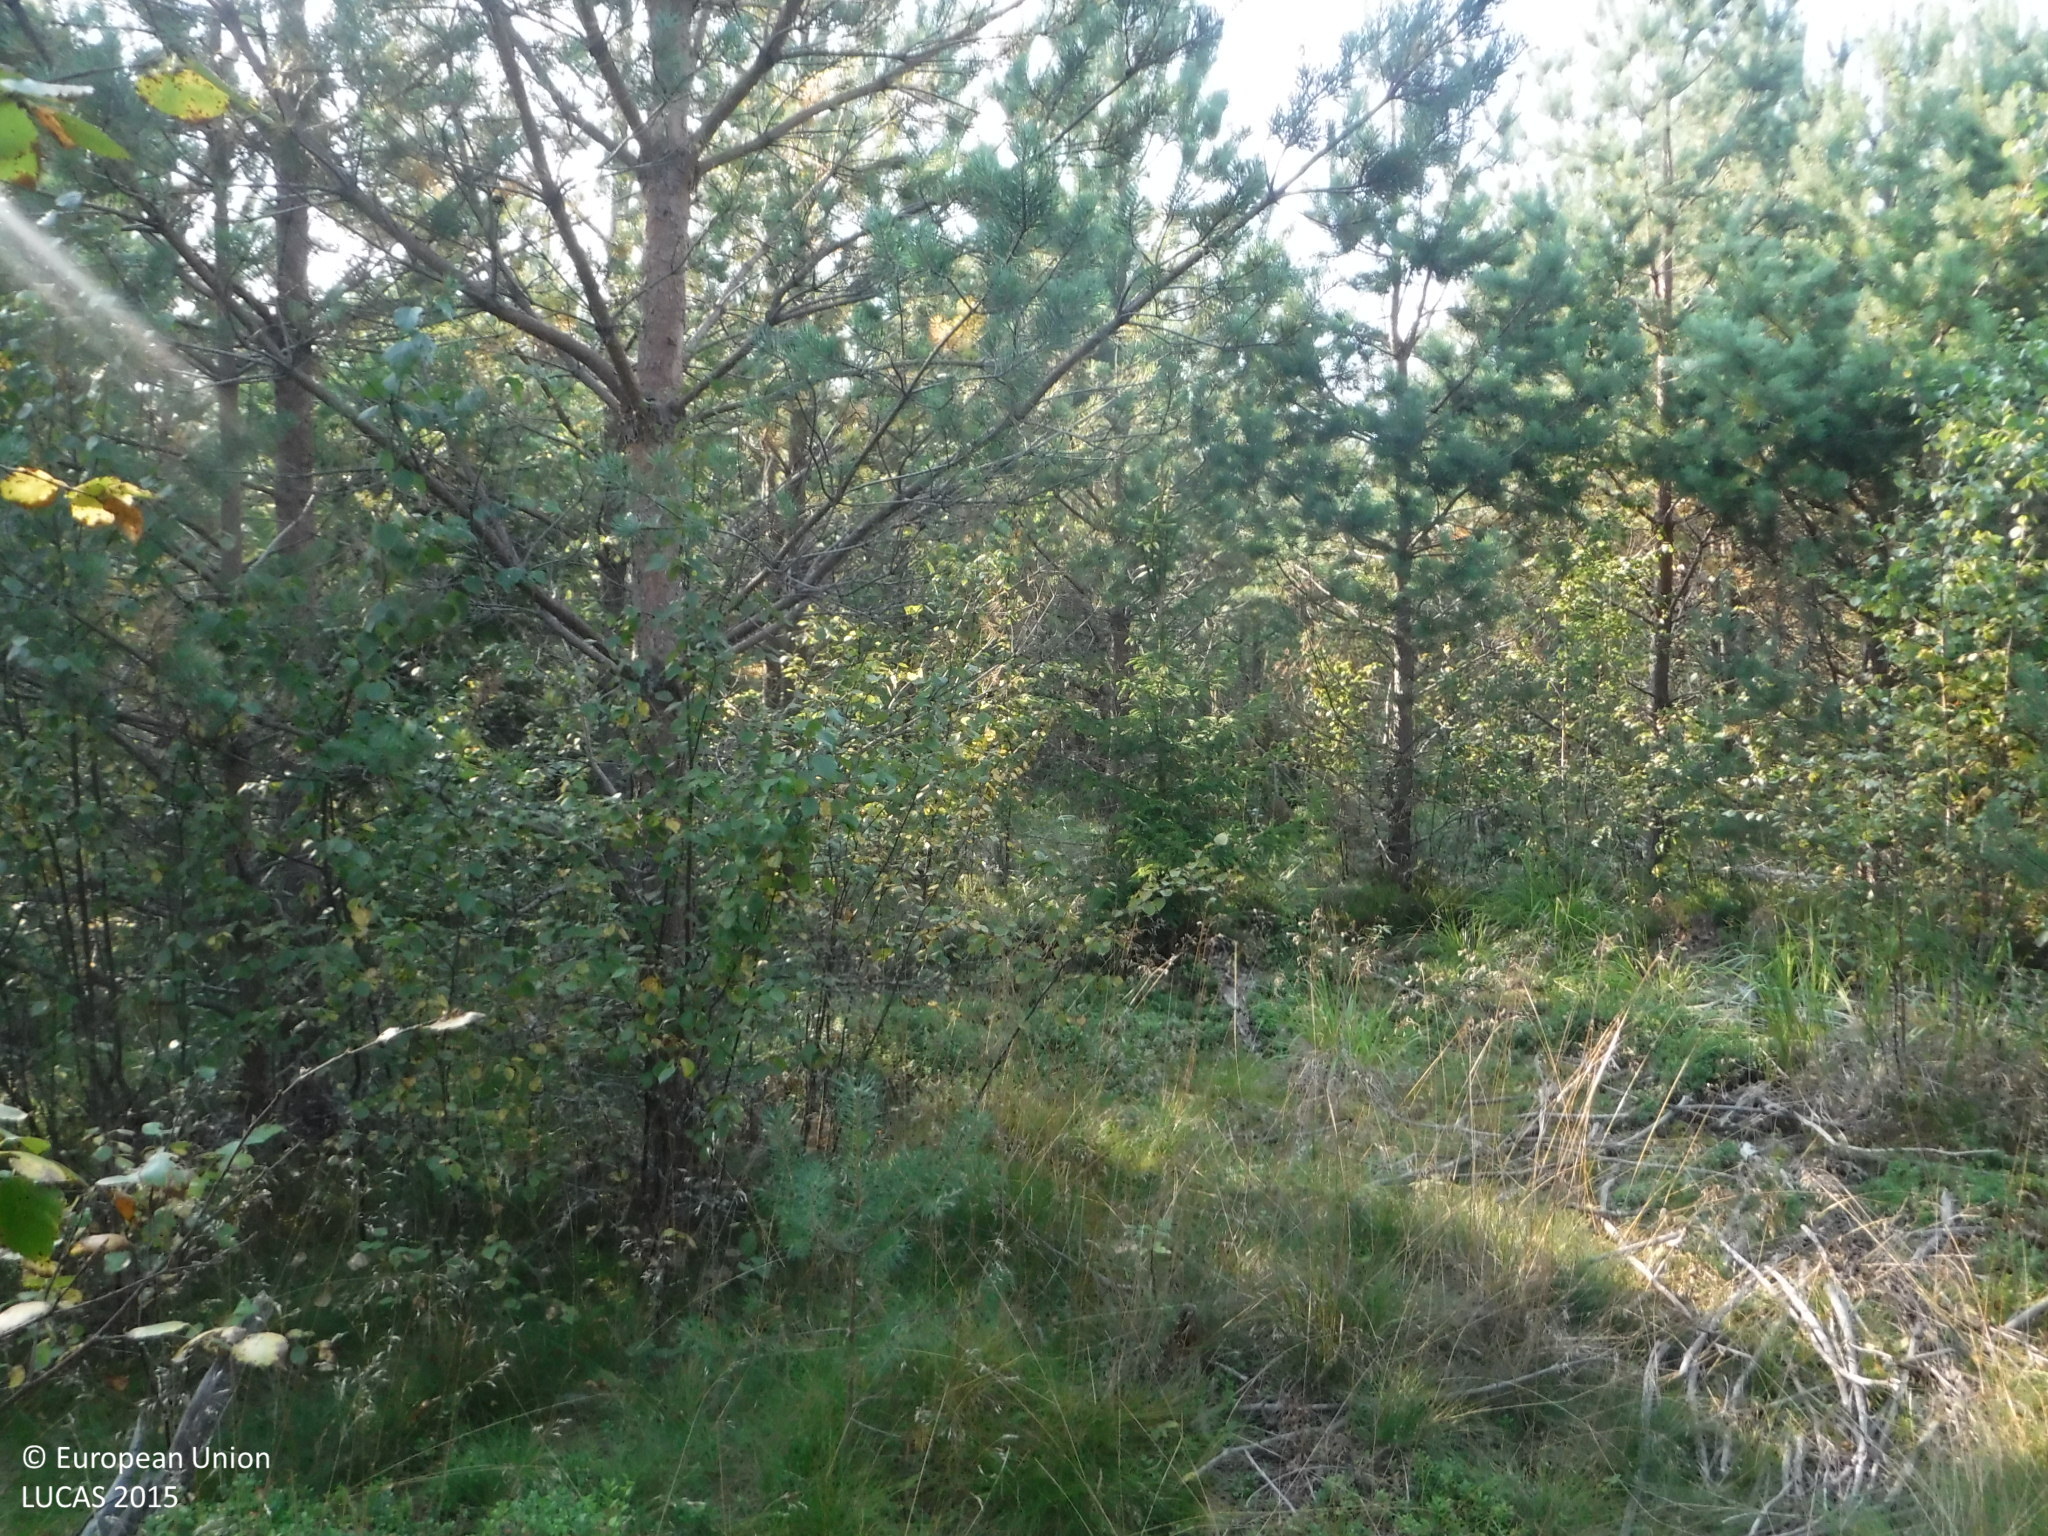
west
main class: Woodland
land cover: Pine dominated coniferous woodland
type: boreal forest
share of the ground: 25 - 50 %
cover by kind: herbaceous plants 50 %, coniferous forest trees 30 %, shrubs 10 %, broadleaved forest trees 5 %, lichens and mosses 5 %
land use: Forestry
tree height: > 5 m
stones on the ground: < 10 %
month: August
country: FI
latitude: 61.2559
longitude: 23.0287
